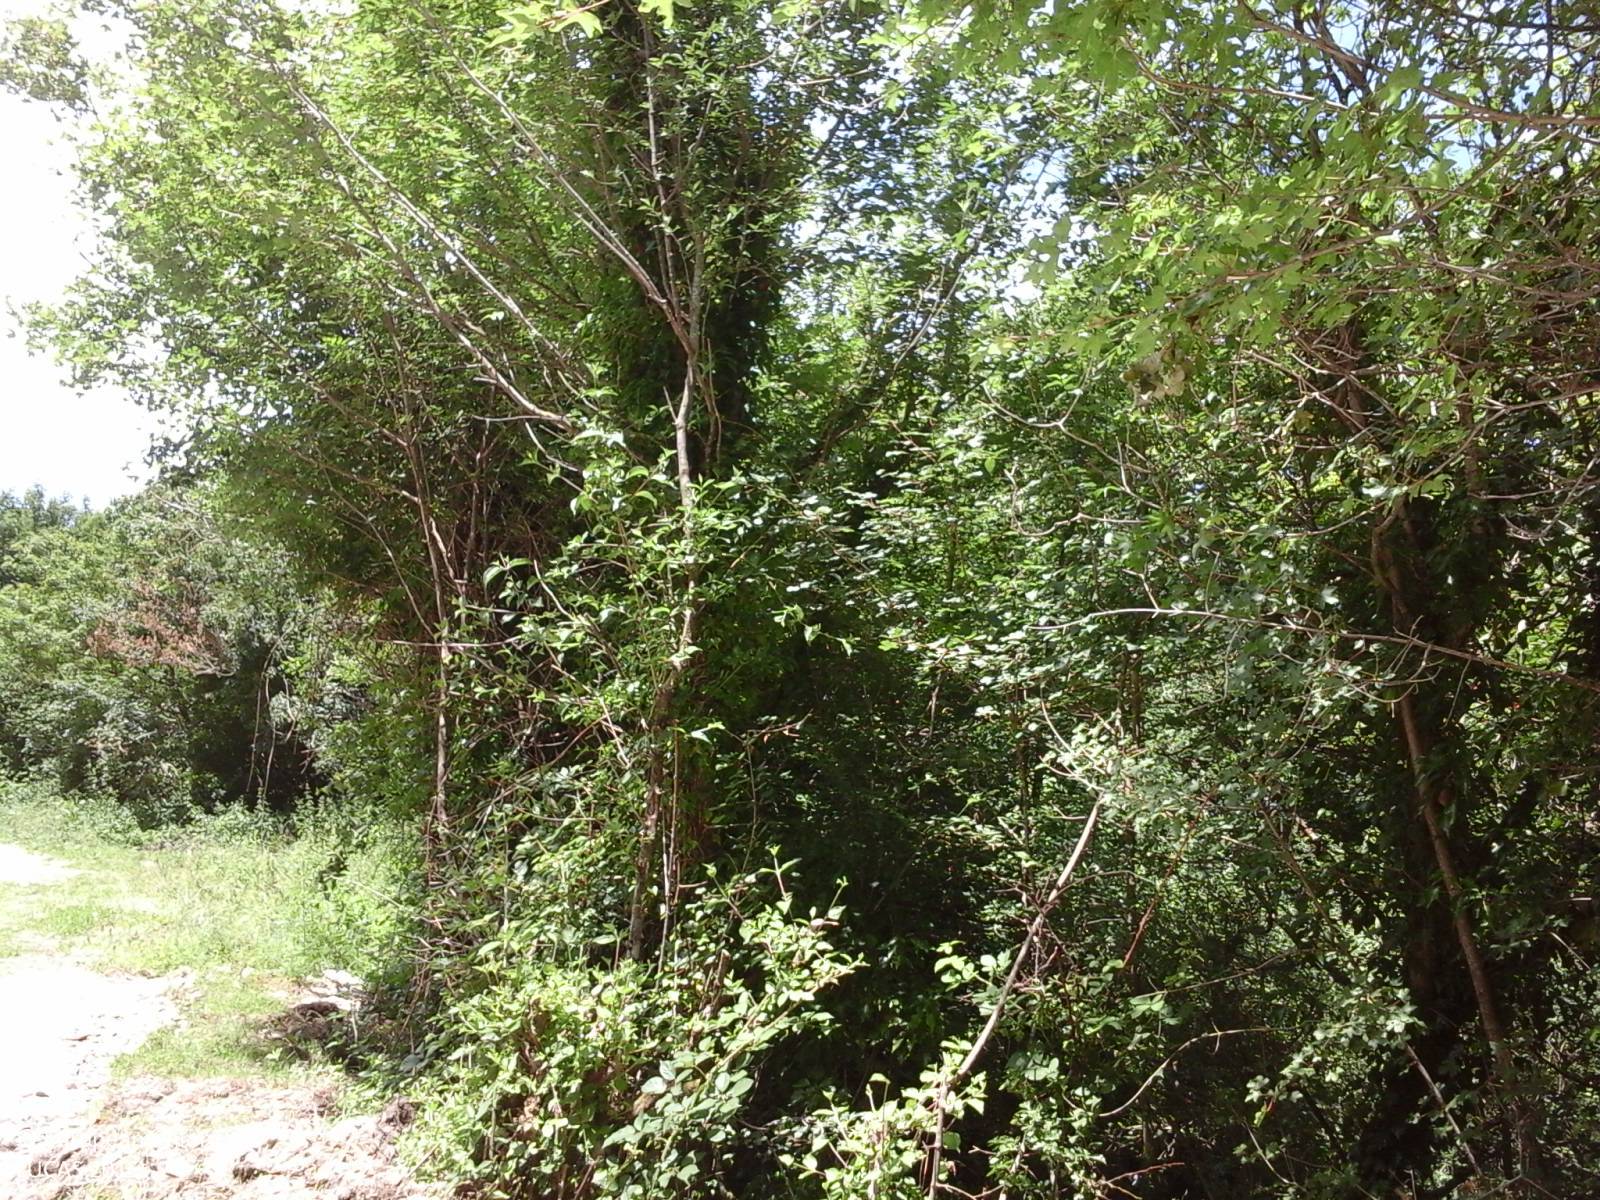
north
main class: Woodland
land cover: Broadleaved woodland
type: thermophilous deciduous forest
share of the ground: > 75 %
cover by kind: broadleaved forest trees 100 %
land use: Semi-natural and natural areas not in use
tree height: < 5 m
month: June
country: IT
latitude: 41.4418
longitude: 14.2810
